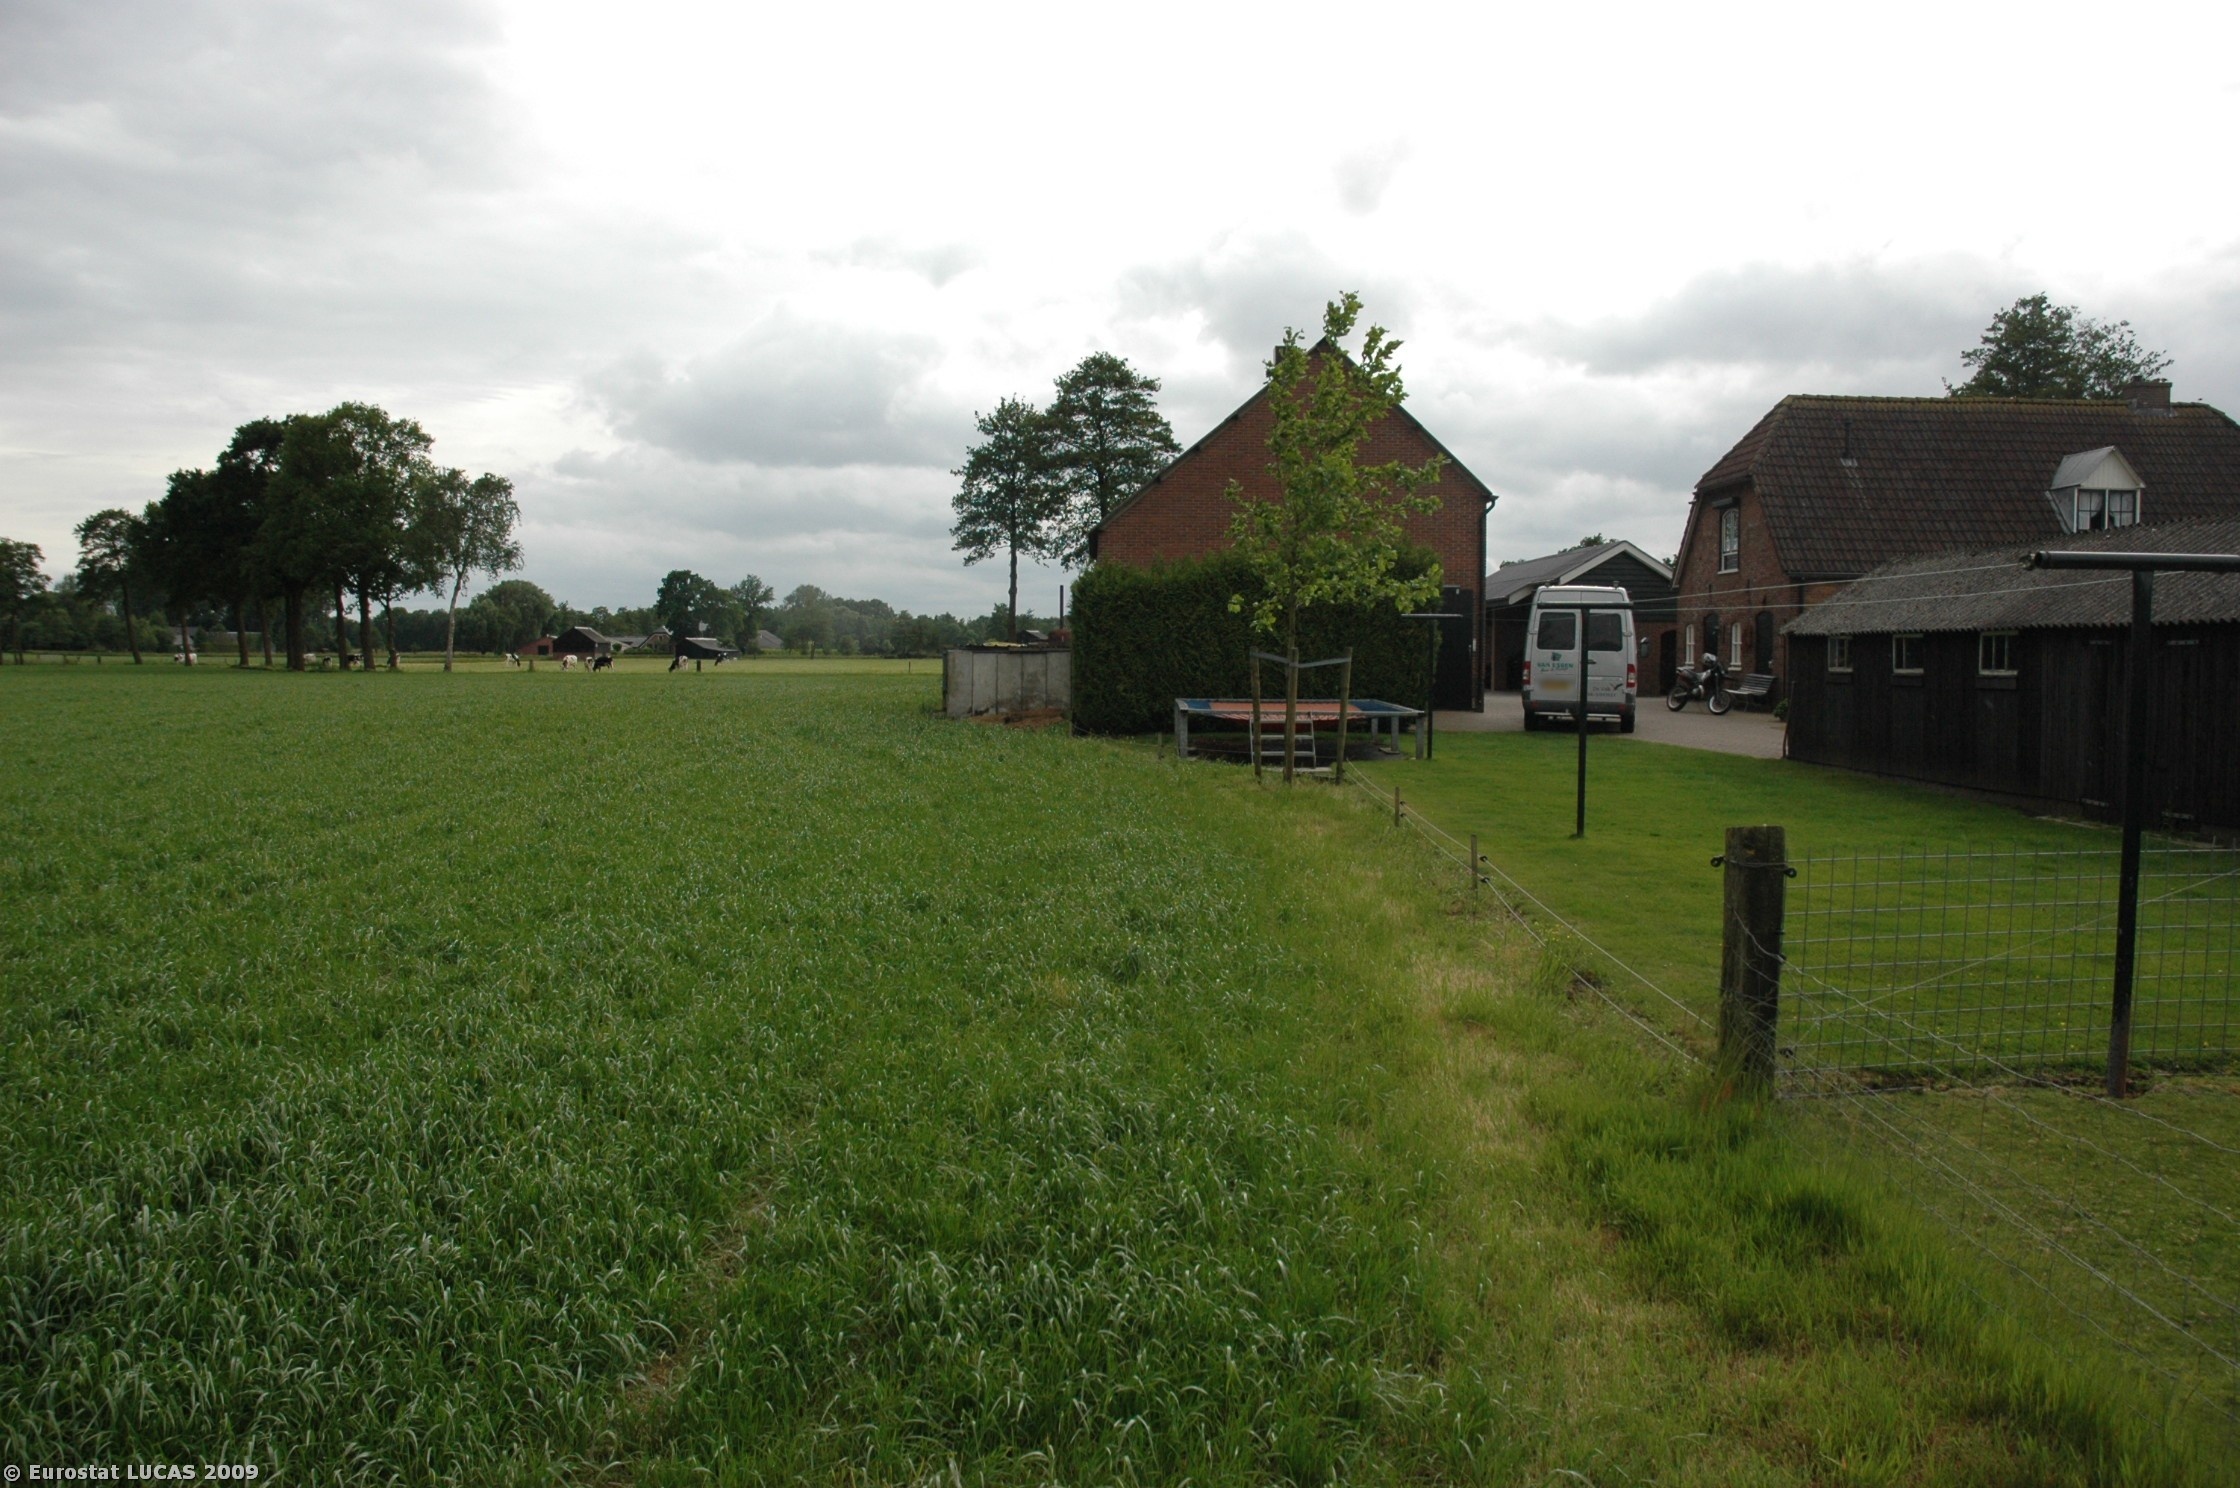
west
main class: Grassland
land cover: Grassland without tree/shrub cover
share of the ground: > 75 %
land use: Agriculture (excluding fallow land and kitchen gardens)
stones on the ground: < 10 %
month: May
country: NL
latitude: 52.1193
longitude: 5.6902
